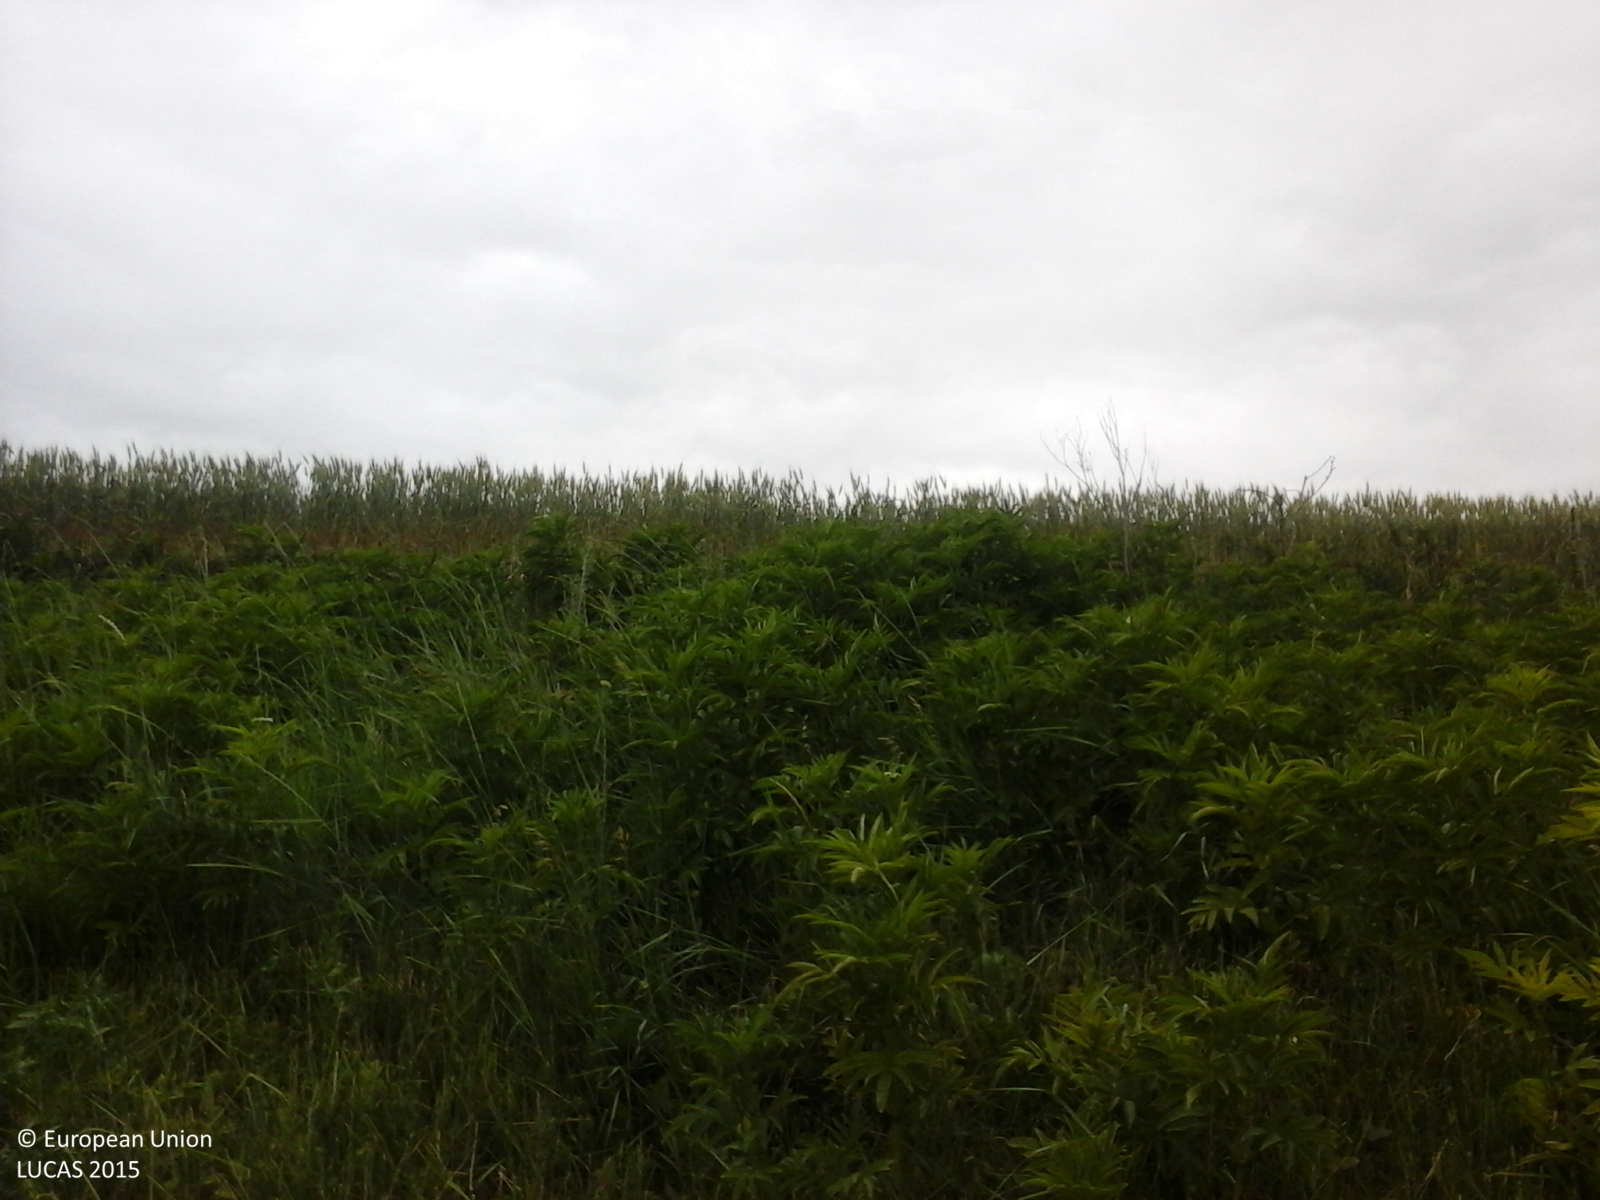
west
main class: Grassland
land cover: Grassland without tree/shrub cover
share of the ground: > 75 %
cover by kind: herbaceous plants 100 %
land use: Agriculture (excluding fallow land and kitchen gardens)
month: June
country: RO
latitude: 46.8180
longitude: 26.6420
